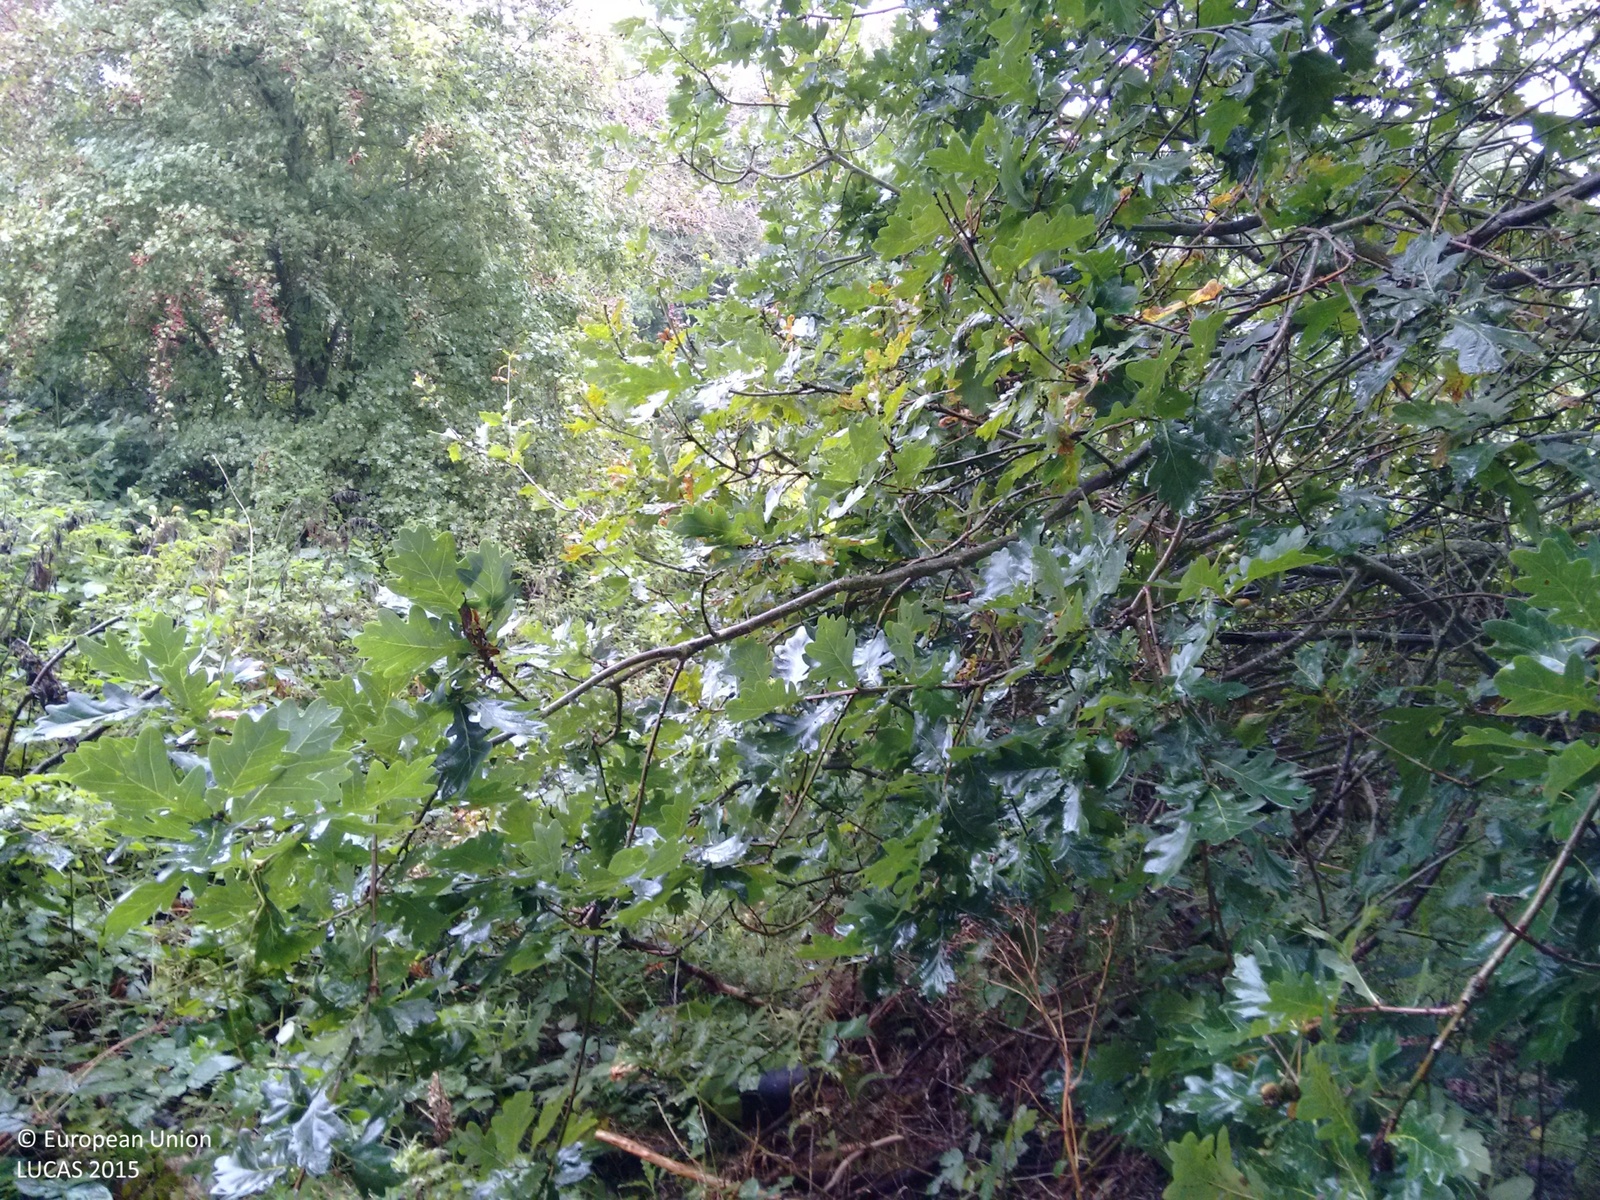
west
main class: Woodland
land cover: Broadleaved woodland
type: mesophytic deciduous forest
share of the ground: > 75 %
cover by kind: broadleaved forest trees 100 %
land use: Amenities, museums, leisure
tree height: > 5 m
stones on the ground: < 10 %
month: October
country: GB
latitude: 52.5055
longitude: 1.7472
